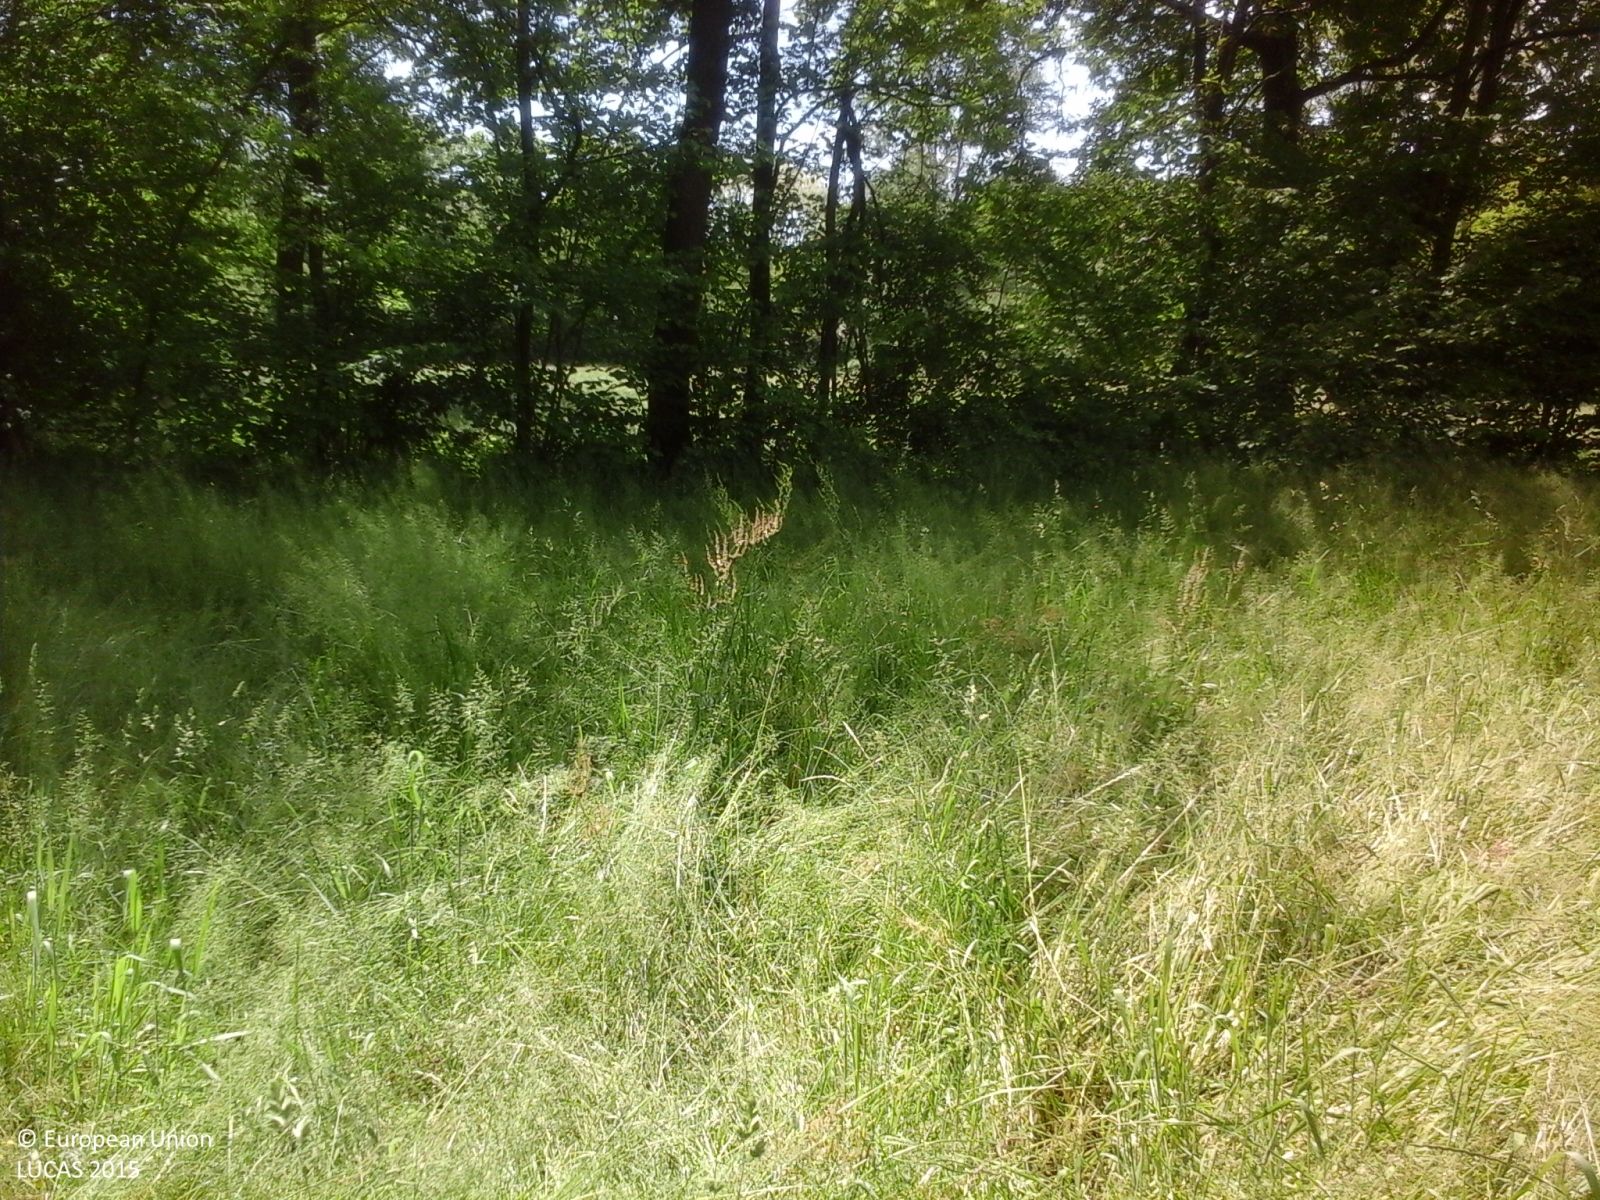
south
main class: Grassland
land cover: Grassland with sparse tree/shrub cover
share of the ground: > 75 %
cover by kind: herbaceous plants 95 %, broadleaved forest trees 5 %
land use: Agriculture (excluding fallow land and kitchen gardens)
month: May
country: IT
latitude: 45.7114
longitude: 8.6020
